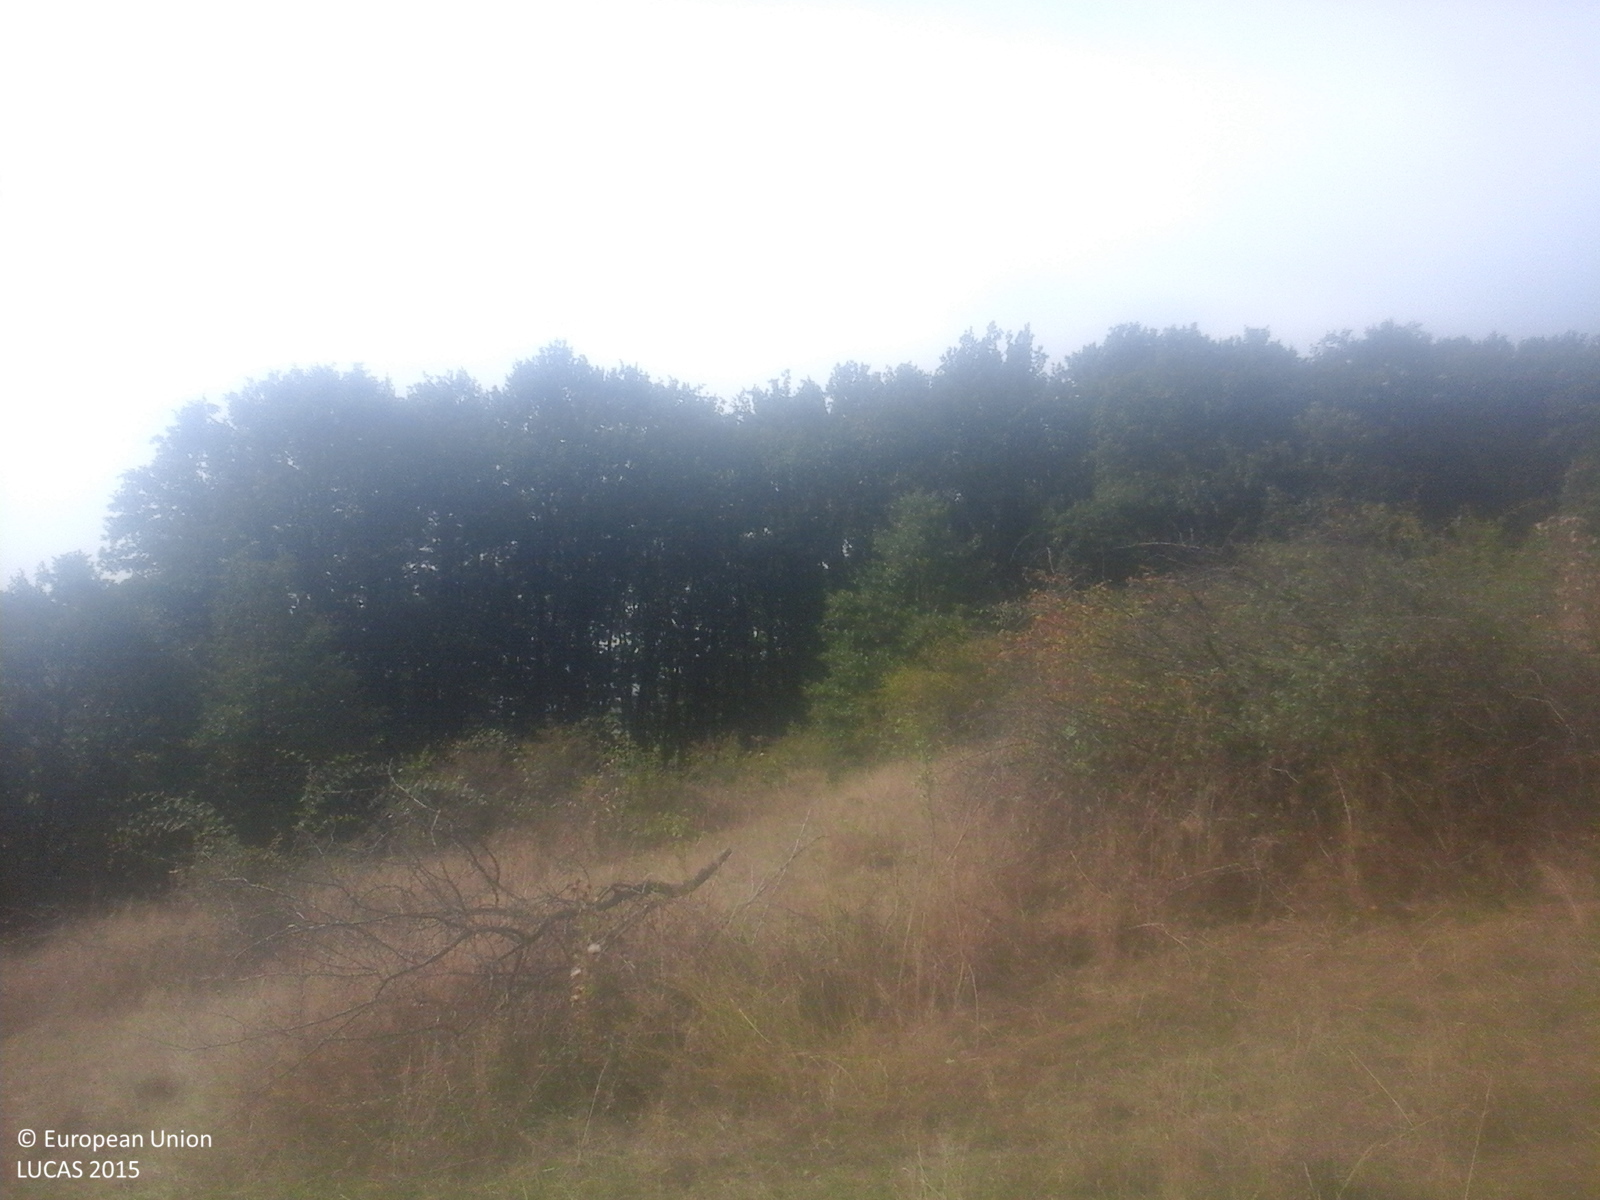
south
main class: Grassland
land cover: Grassland with sparse tree/shrub cover
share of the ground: > 75 %
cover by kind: herbaceous plants 85 %, shrubs 10 %, broadleaved forest trees 5 %
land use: Agriculture (excluding fallow land and kitchen gardens)
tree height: < 5 m
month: September
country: RO
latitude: 47.0485
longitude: 23.5912
